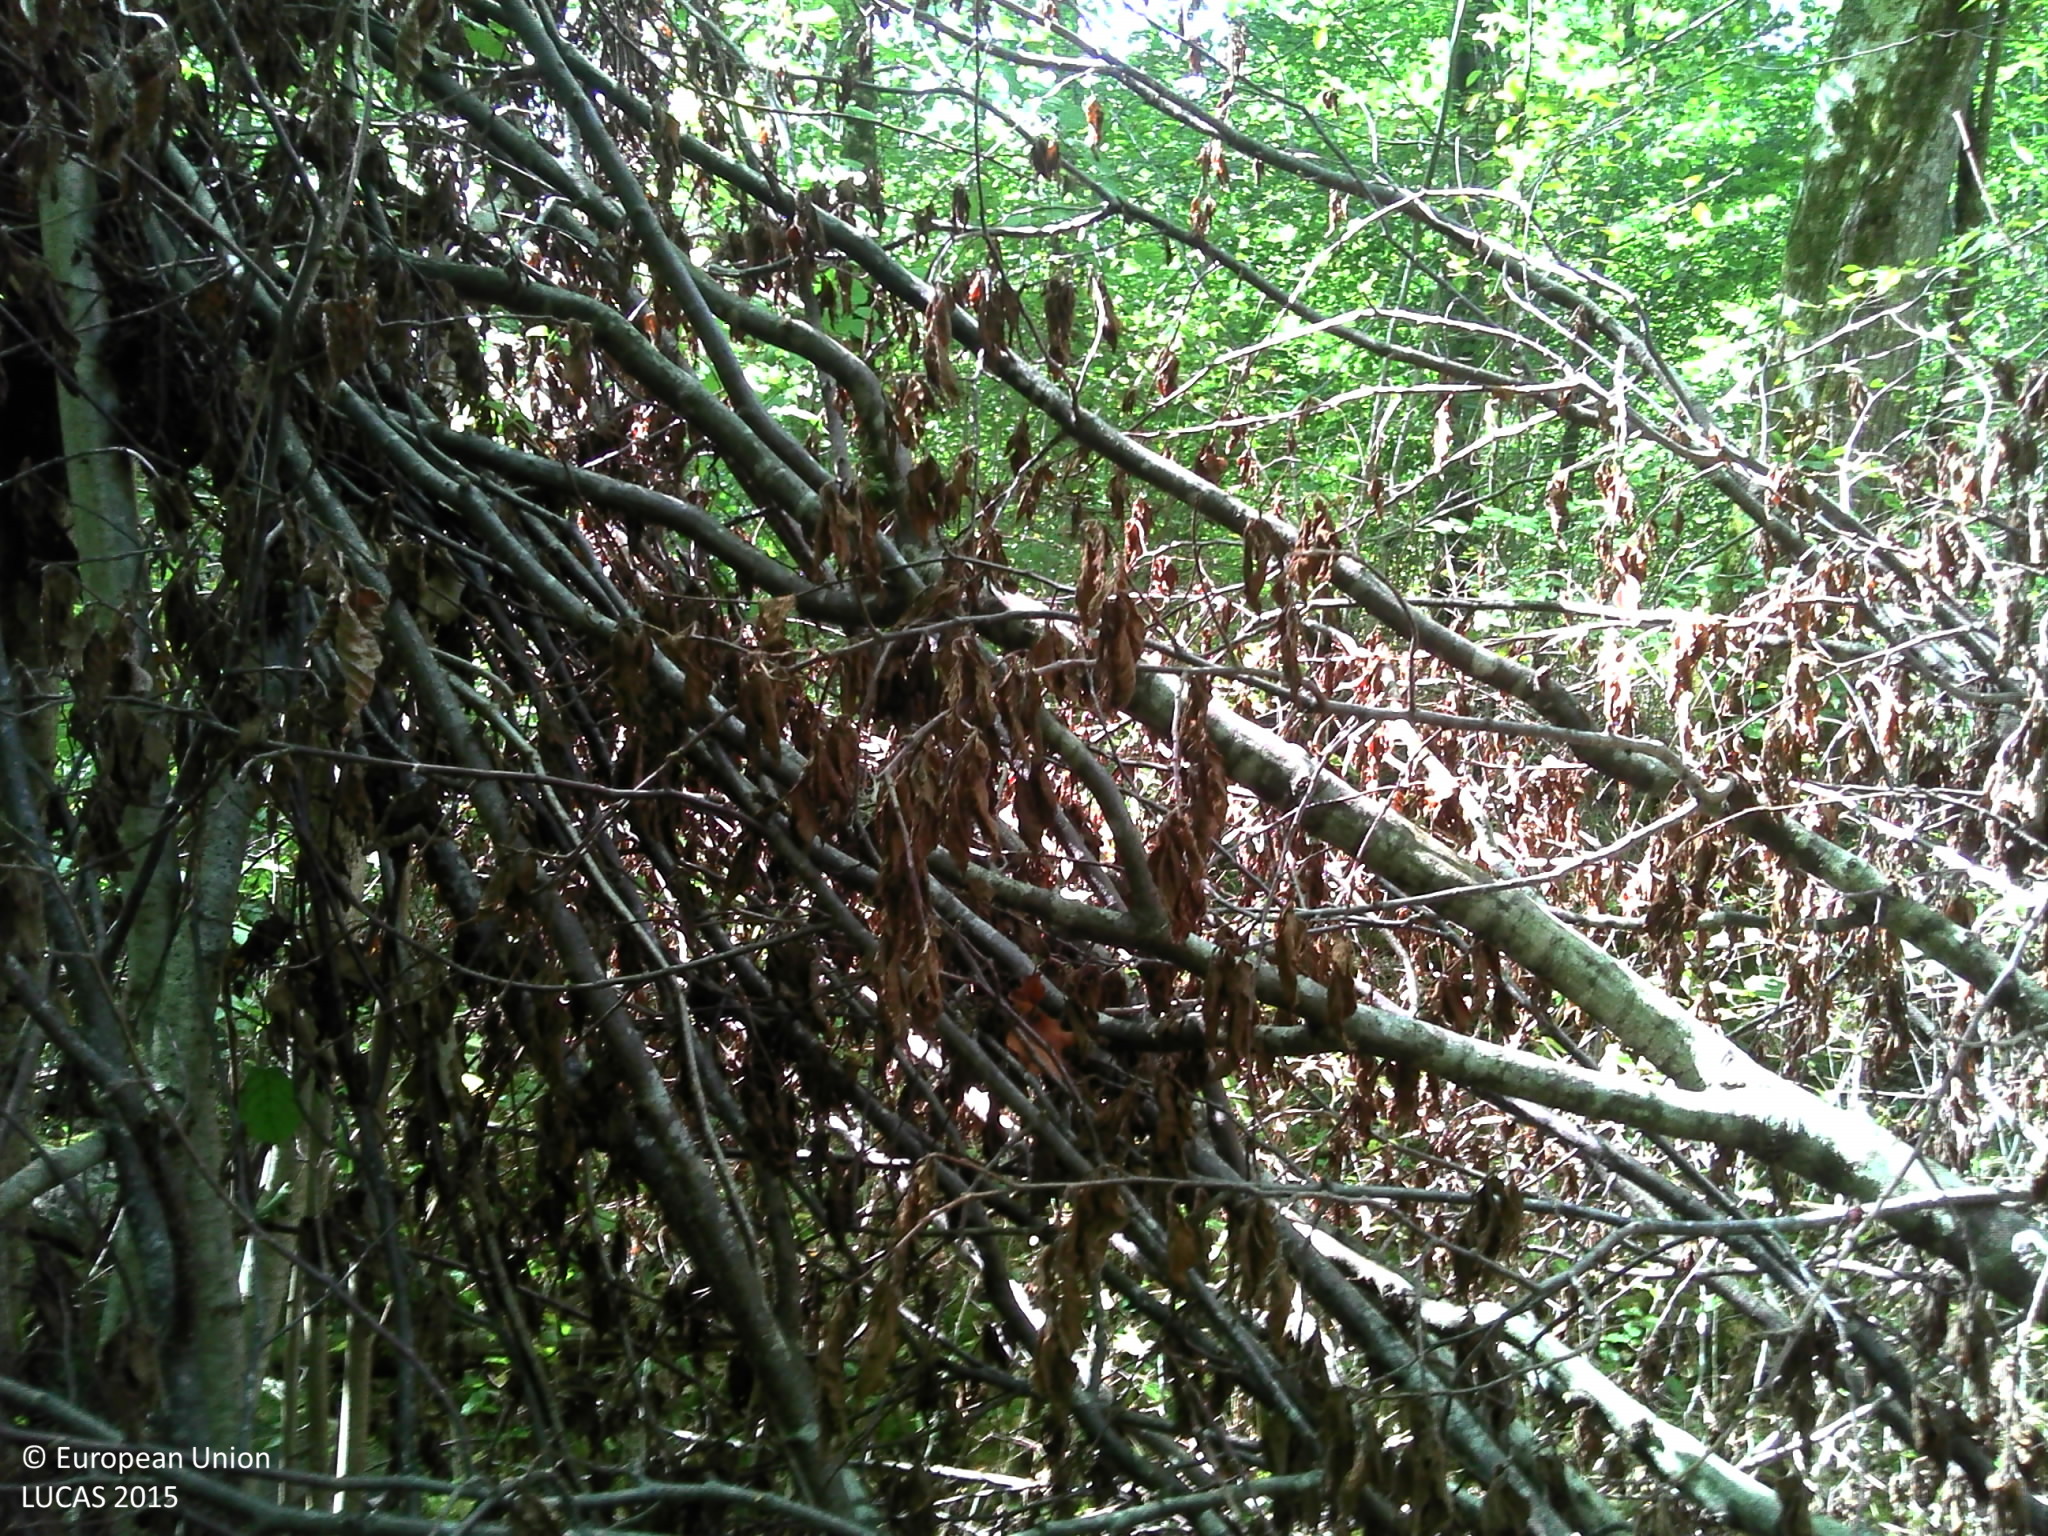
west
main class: Woodland
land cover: Broadleaved woodland
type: mesophytic deciduous forest
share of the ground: > 75 %
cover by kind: broadleaved forest trees 90 %, herbaceous plants 5 %, lichens and mosses 5 %
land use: Forestry
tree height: > 5 m
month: August
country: FR
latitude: 47.8228
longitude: 4.6426
